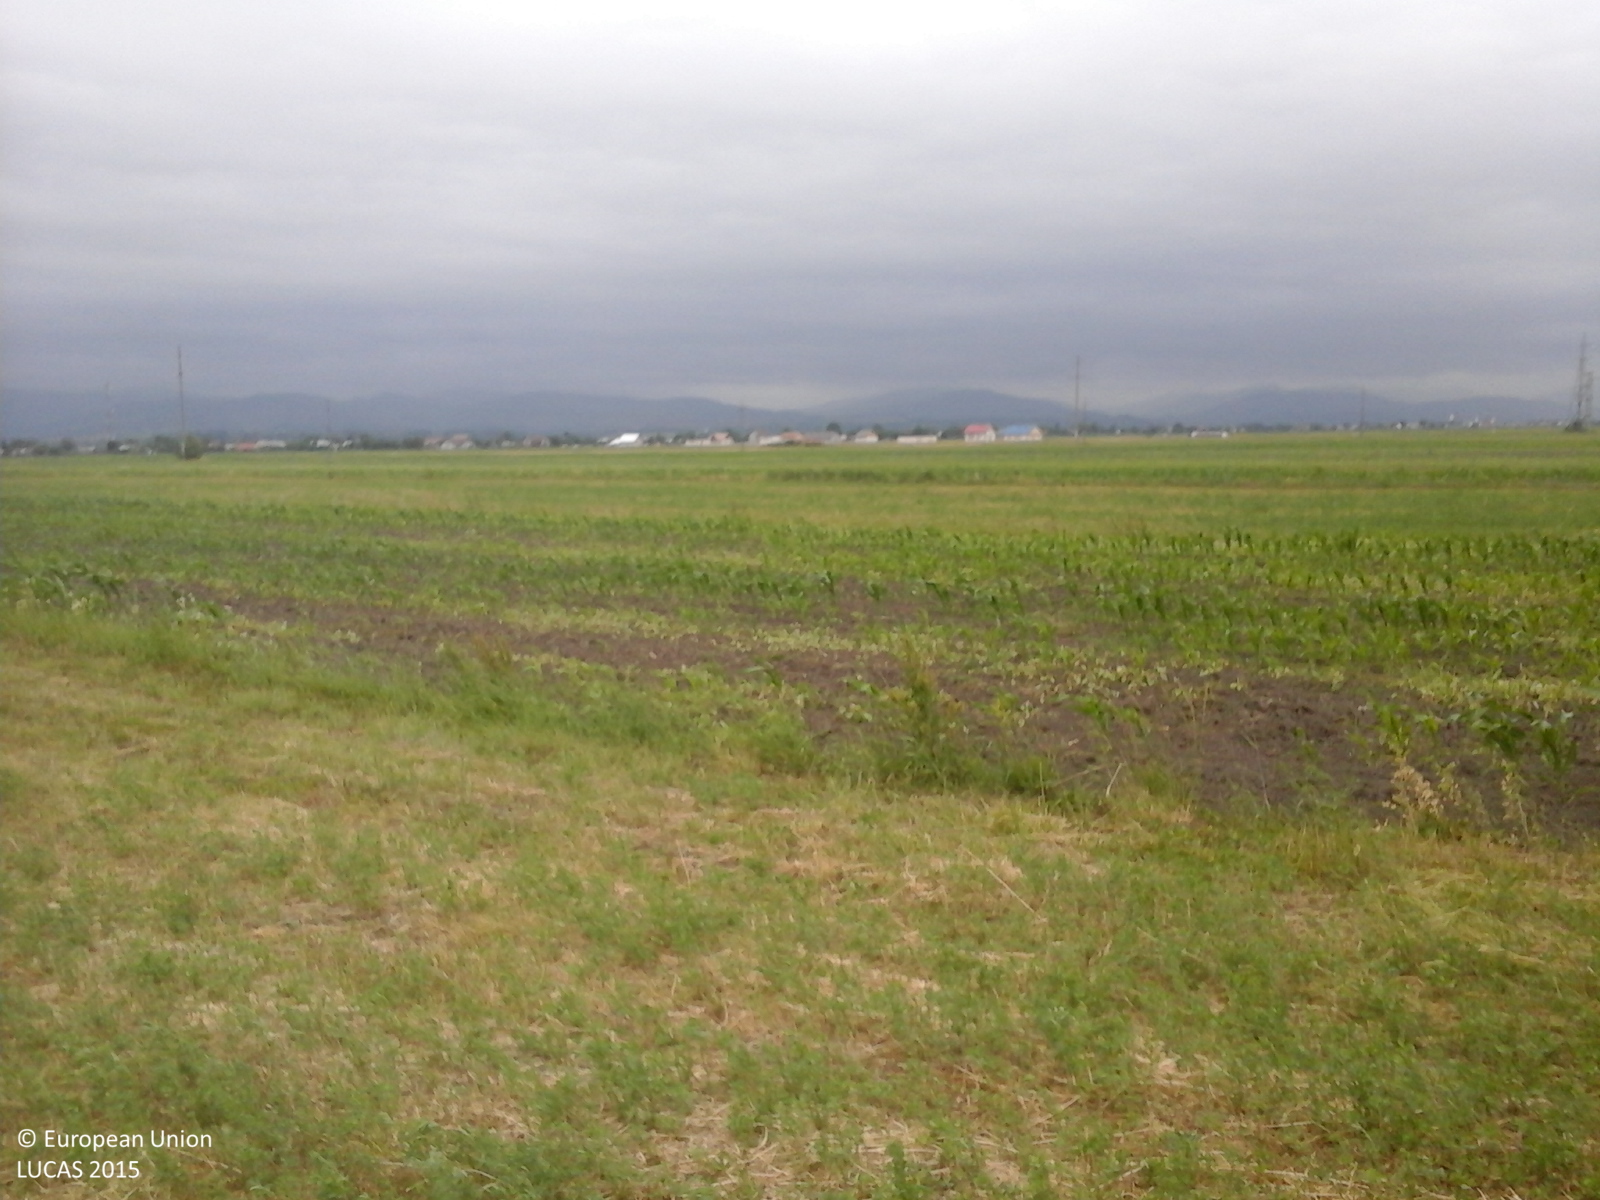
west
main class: Cropland
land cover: Lucerne
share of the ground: > 75 %
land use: Agriculture (excluding fallow land and kitchen gardens)
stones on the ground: < 10 %
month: June
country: RO
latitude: 46.8086
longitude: 26.5851
